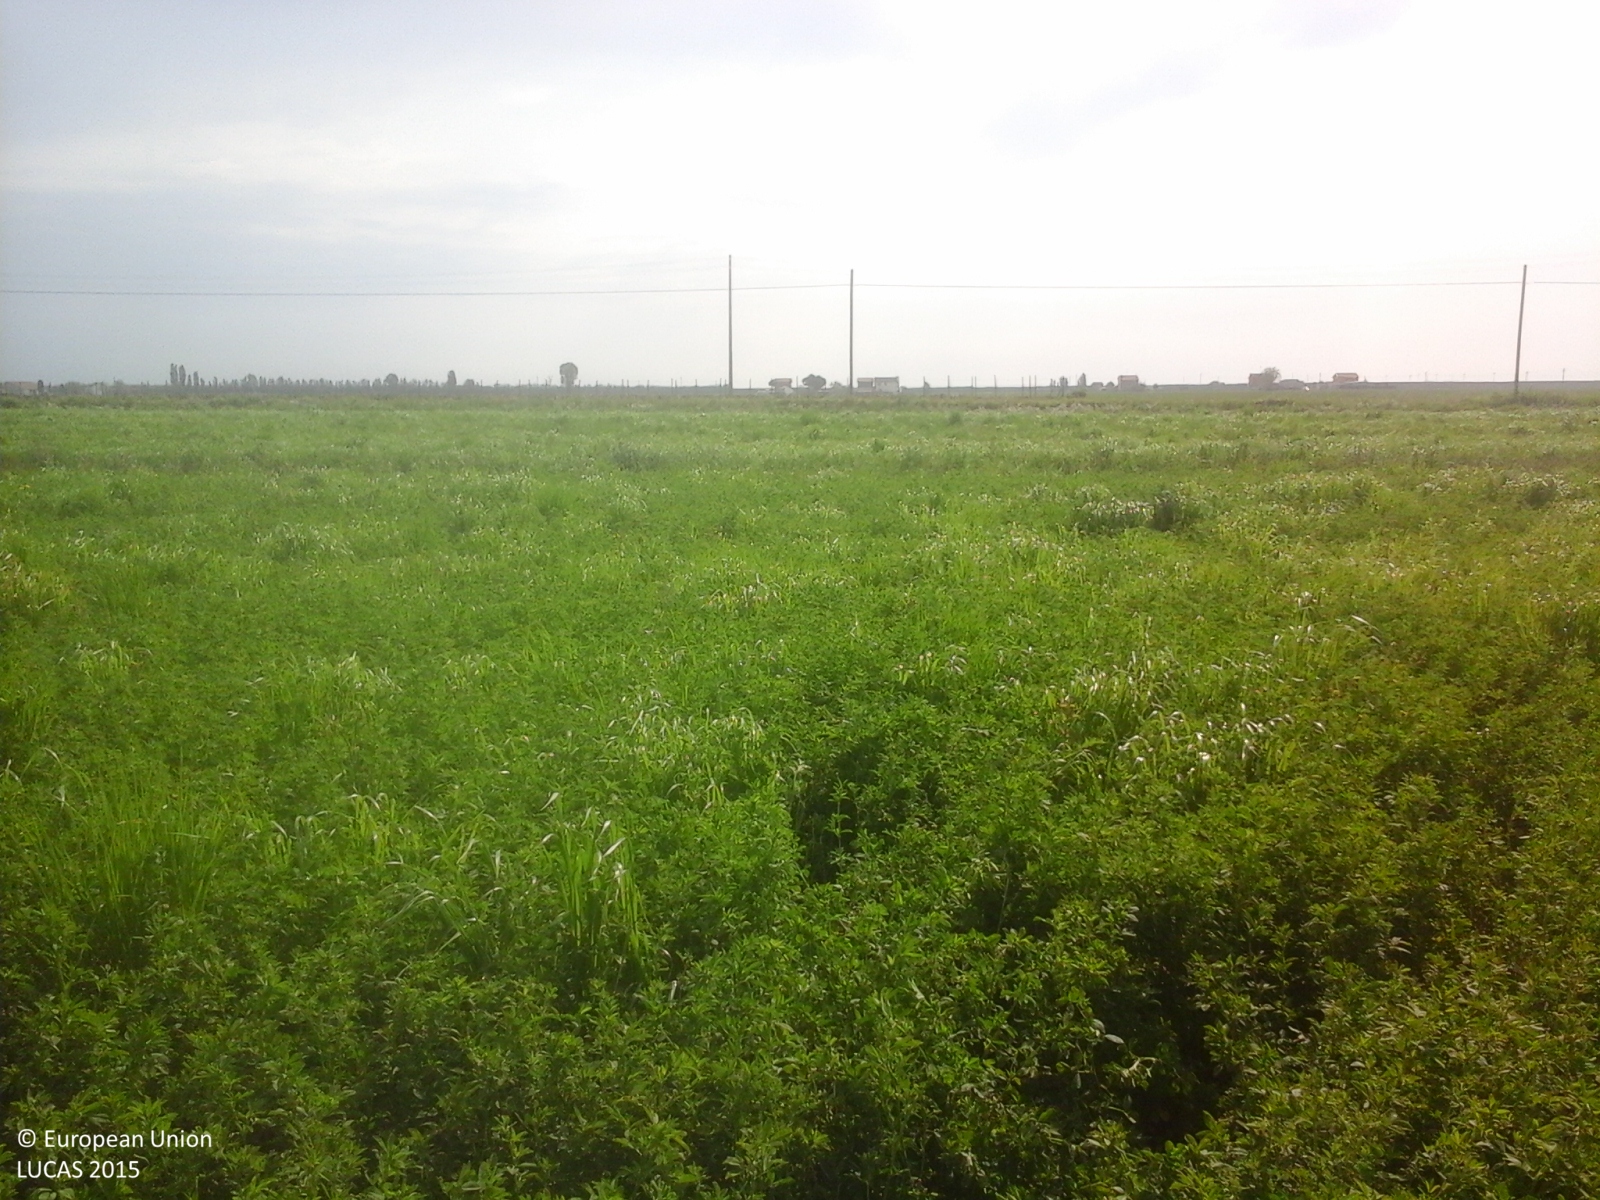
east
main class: Cropland
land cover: Lucerne
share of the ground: > 75 %
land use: Agriculture (excluding fallow land and kitchen gardens)
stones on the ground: < 10 %
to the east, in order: Lucerne; Ditches and canals; Lucerne; Grass margins; Inland fresh running water; Grass margins; Paved roads, cycling and walking lanes; Grass margins; Electric lines; Lucerne; Electric lines; Lucerne; Vineyards; Managed hedges; Ditches and canals; Lucerne; Ditches and canals; Lucerne; Ditches and canals; Lucerne
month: April
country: IT
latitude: 44.9899
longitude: 12.4183
